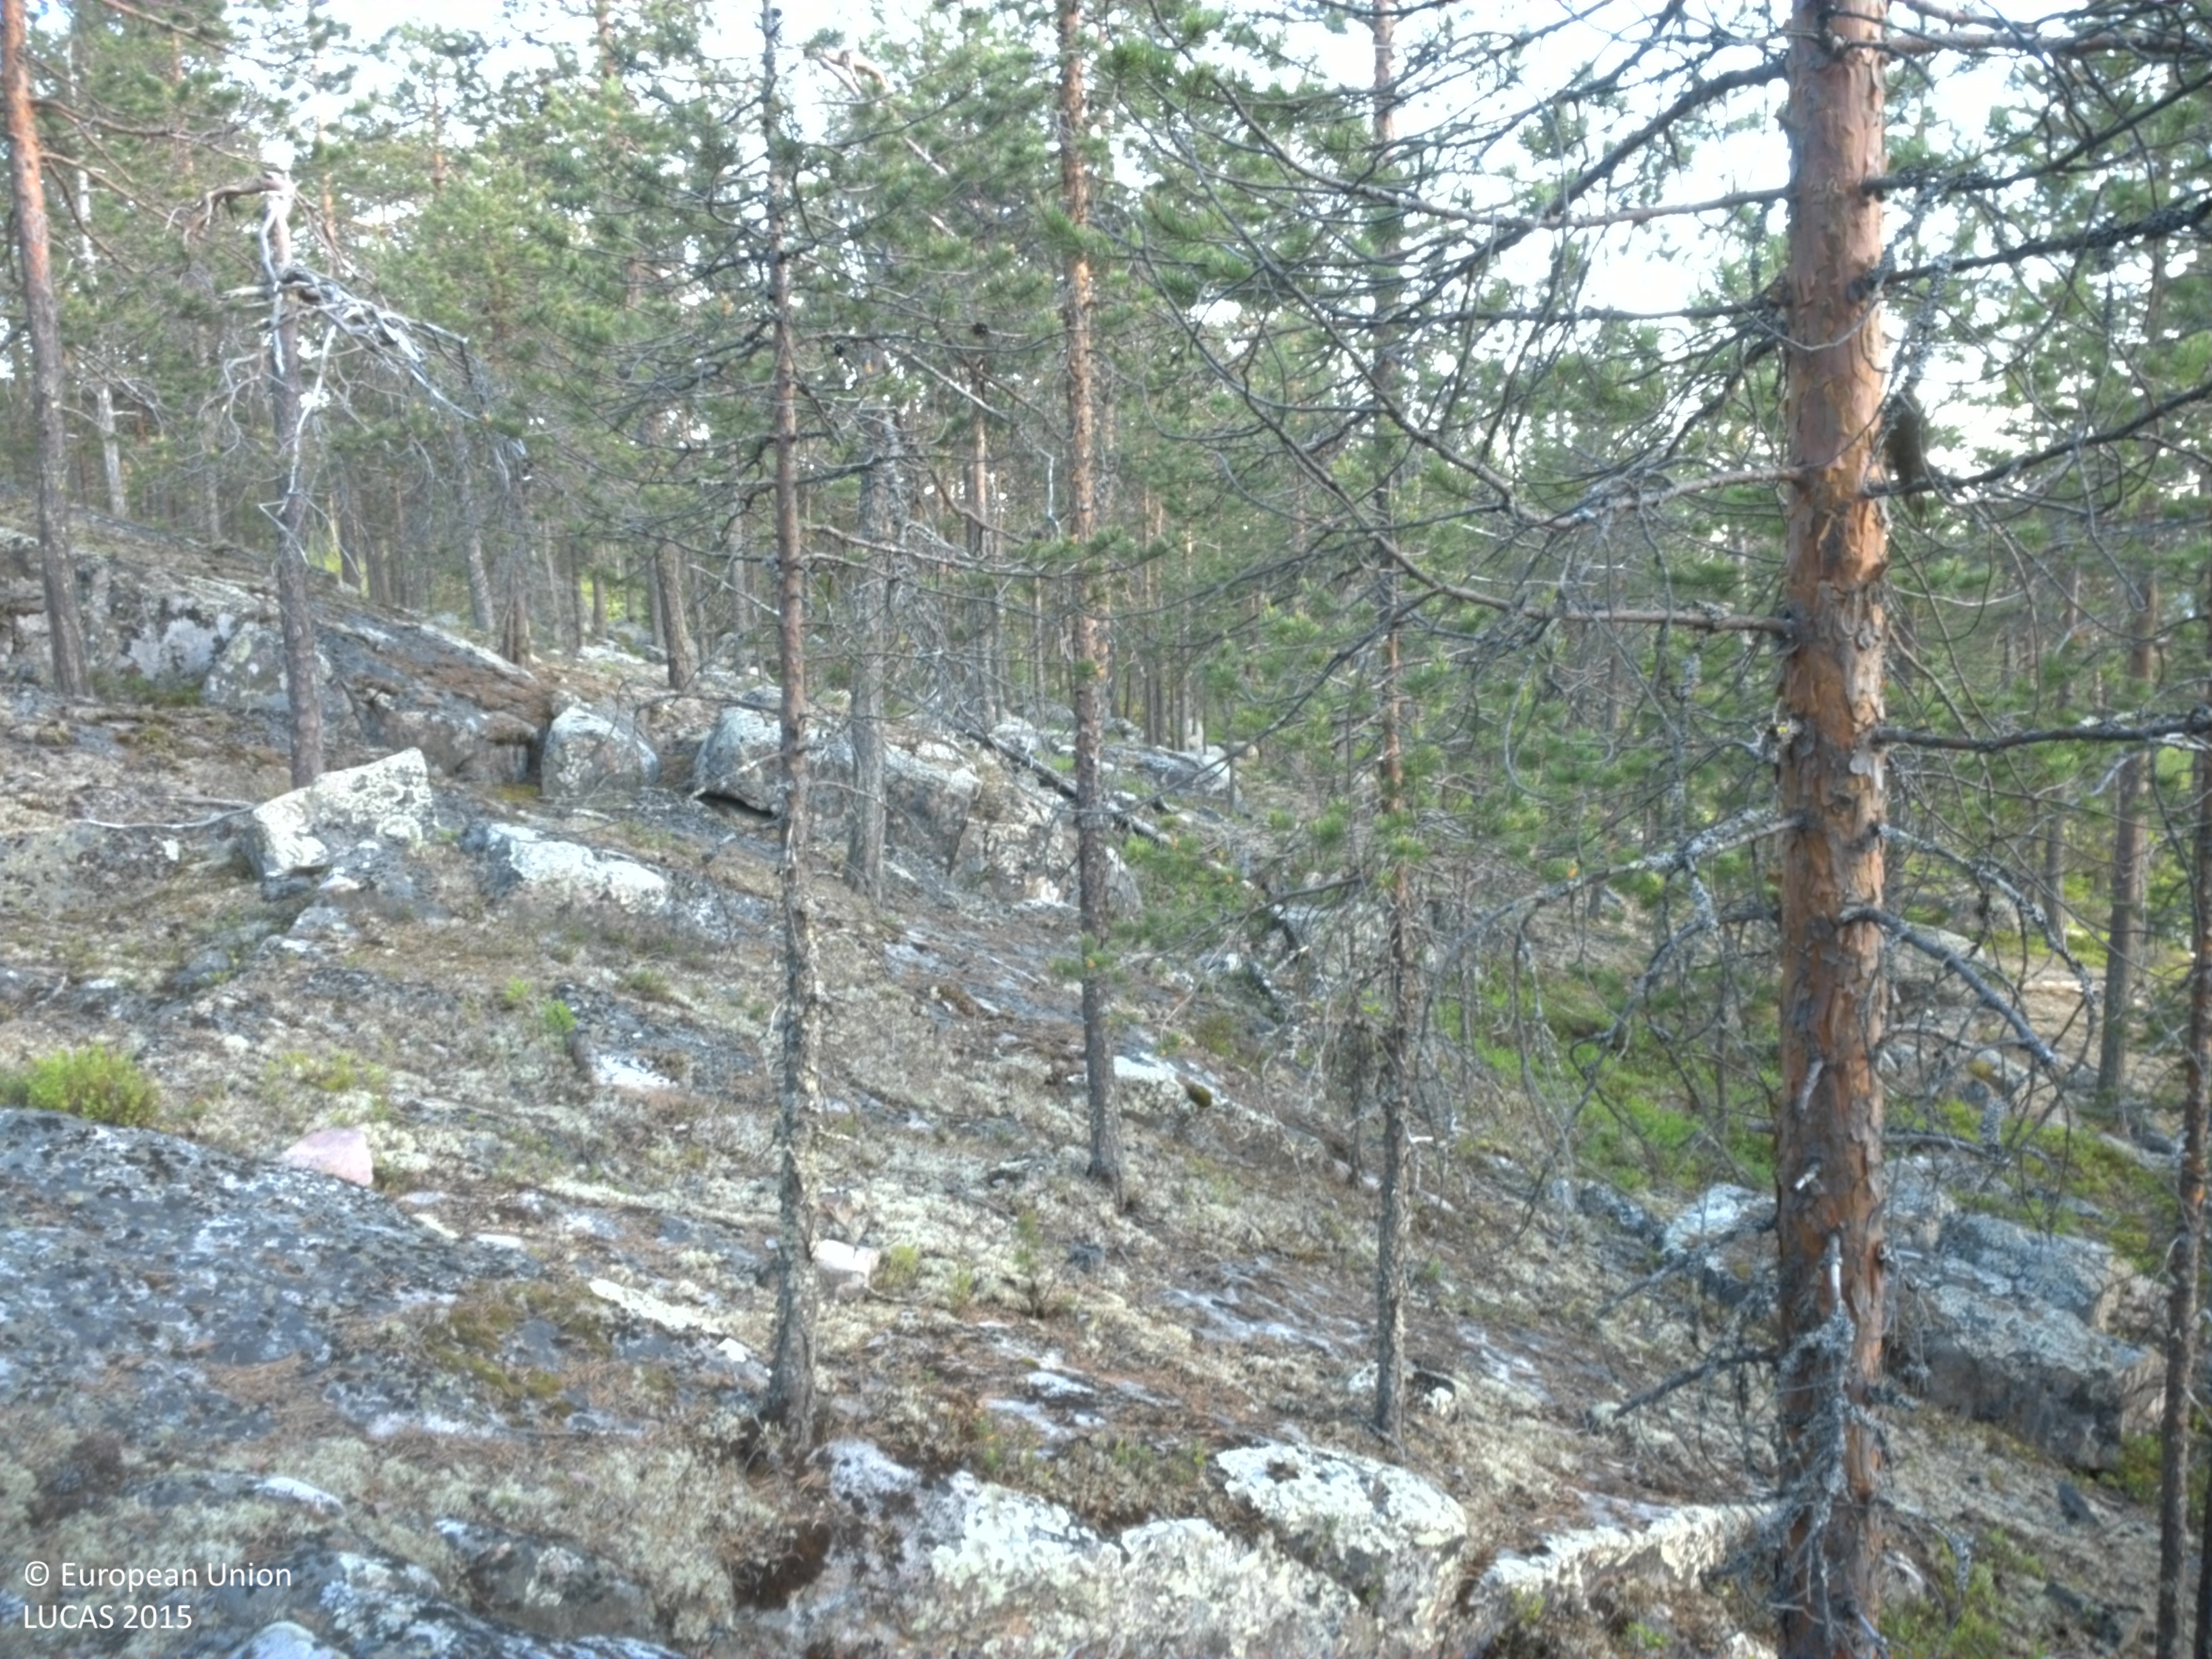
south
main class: Woodland
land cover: Pine dominated coniferous woodland
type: boreal forest
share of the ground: 10 - 25 %
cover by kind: consolidated bare surface 60 %, coniferous forest trees 20 %, lichens and mosses 15 %, shrubs 5 %
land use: Semi-natural and natural areas not in use
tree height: > 5 m
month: June
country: SE
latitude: 66.3163
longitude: 22.8509
